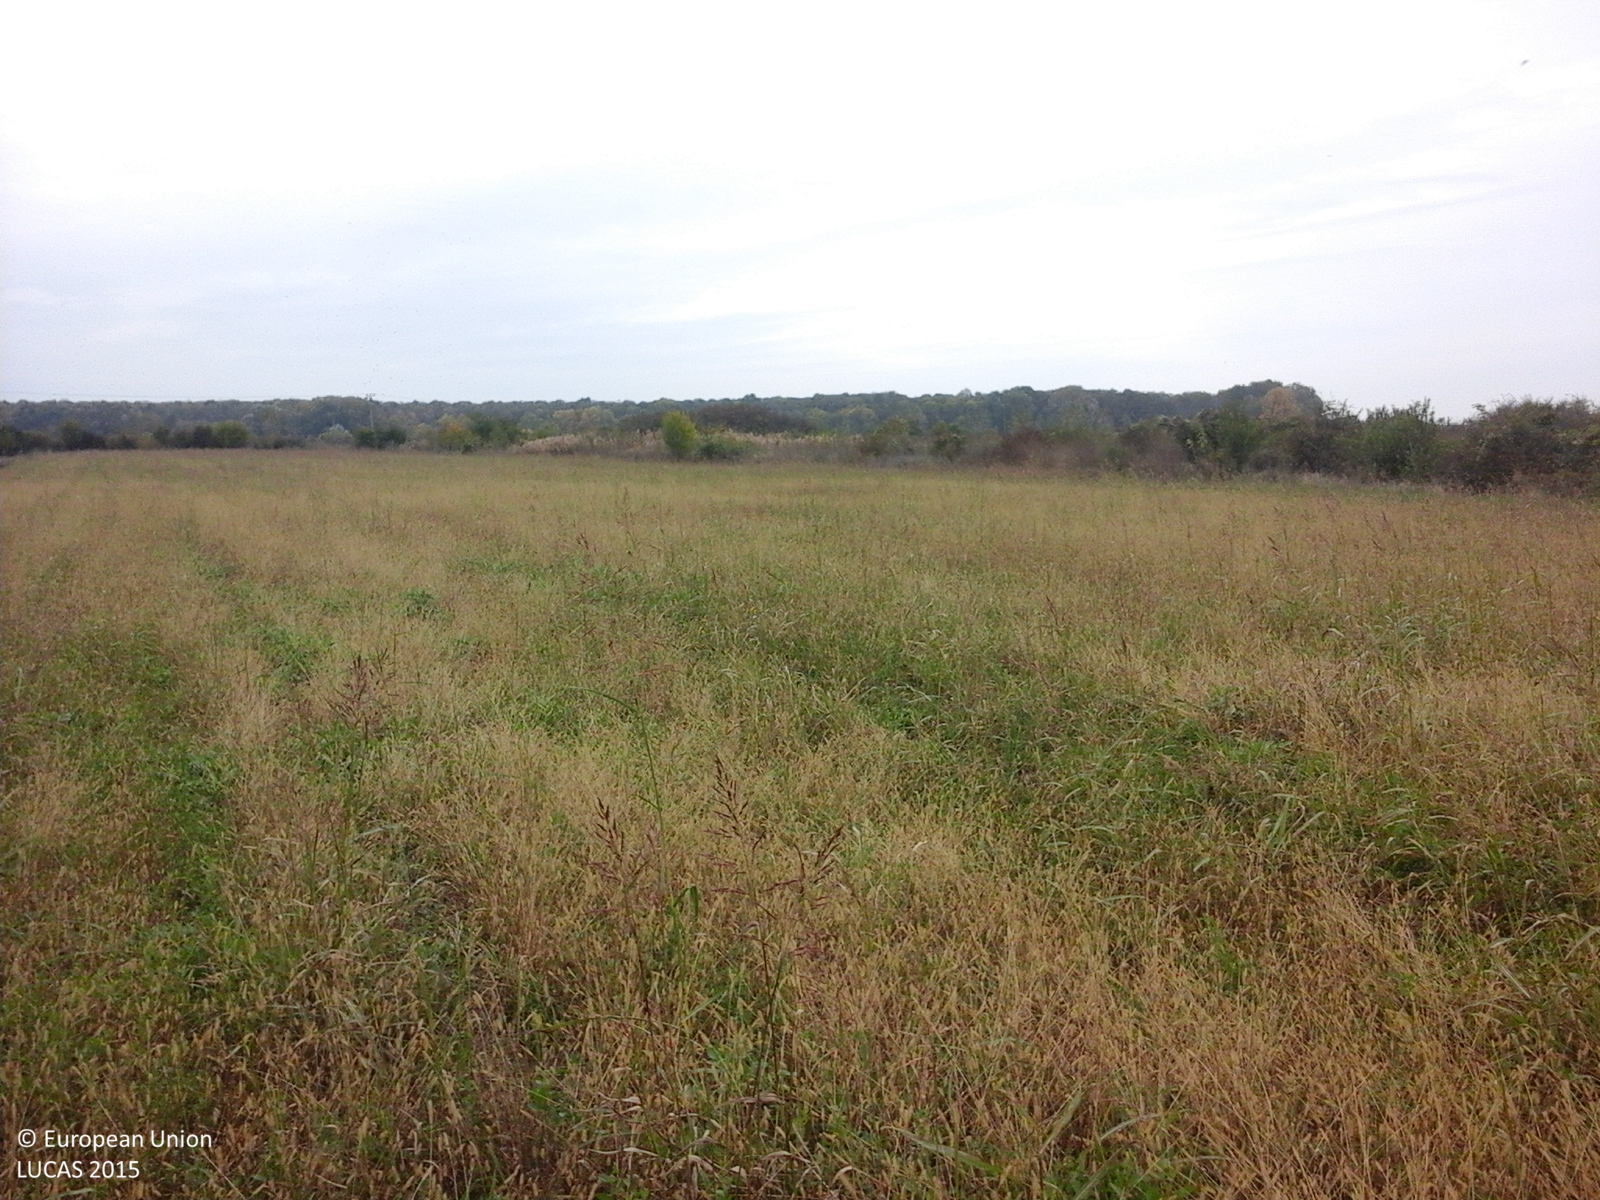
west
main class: Grassland
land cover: Spontaneously vegetated surfaces
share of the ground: > 75 %
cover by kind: herbaceous plants 100 %
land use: Fallow land
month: October
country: RO
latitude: 44.7990
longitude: 26.0487
